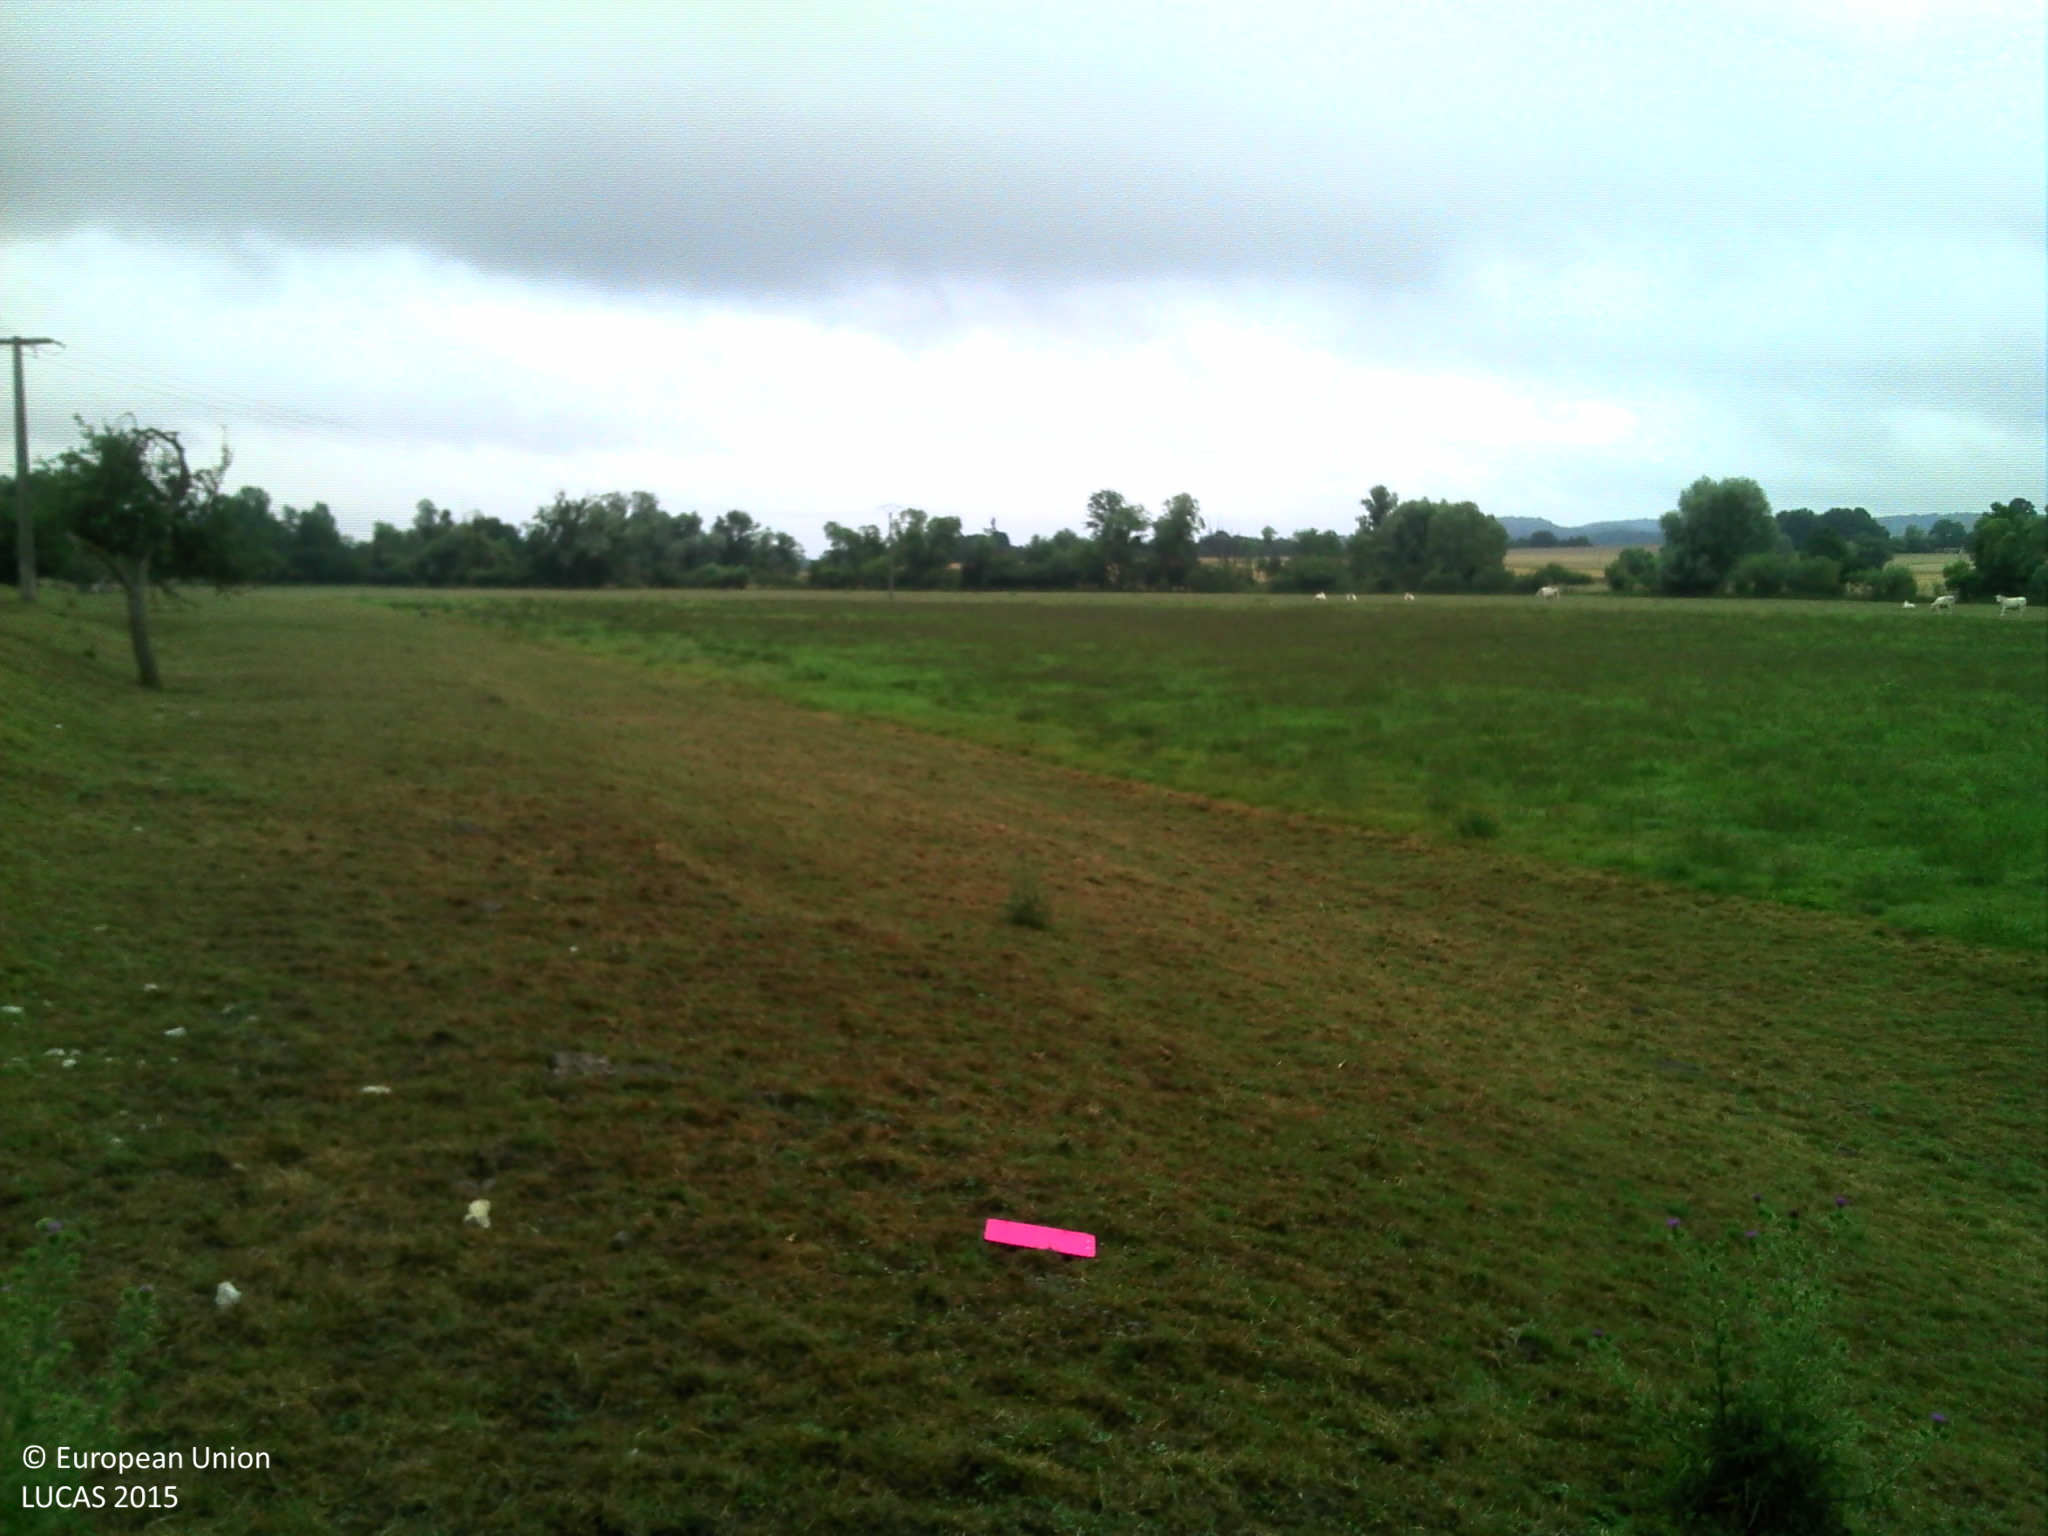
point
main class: Grassland
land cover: Grassland without tree/shrub cover
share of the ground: > 75 %
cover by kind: herbaceous plants 100 %
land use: Agriculture (excluding fallow land and kitchen gardens)
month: July
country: FR
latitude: 49.1757
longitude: 5.0459
